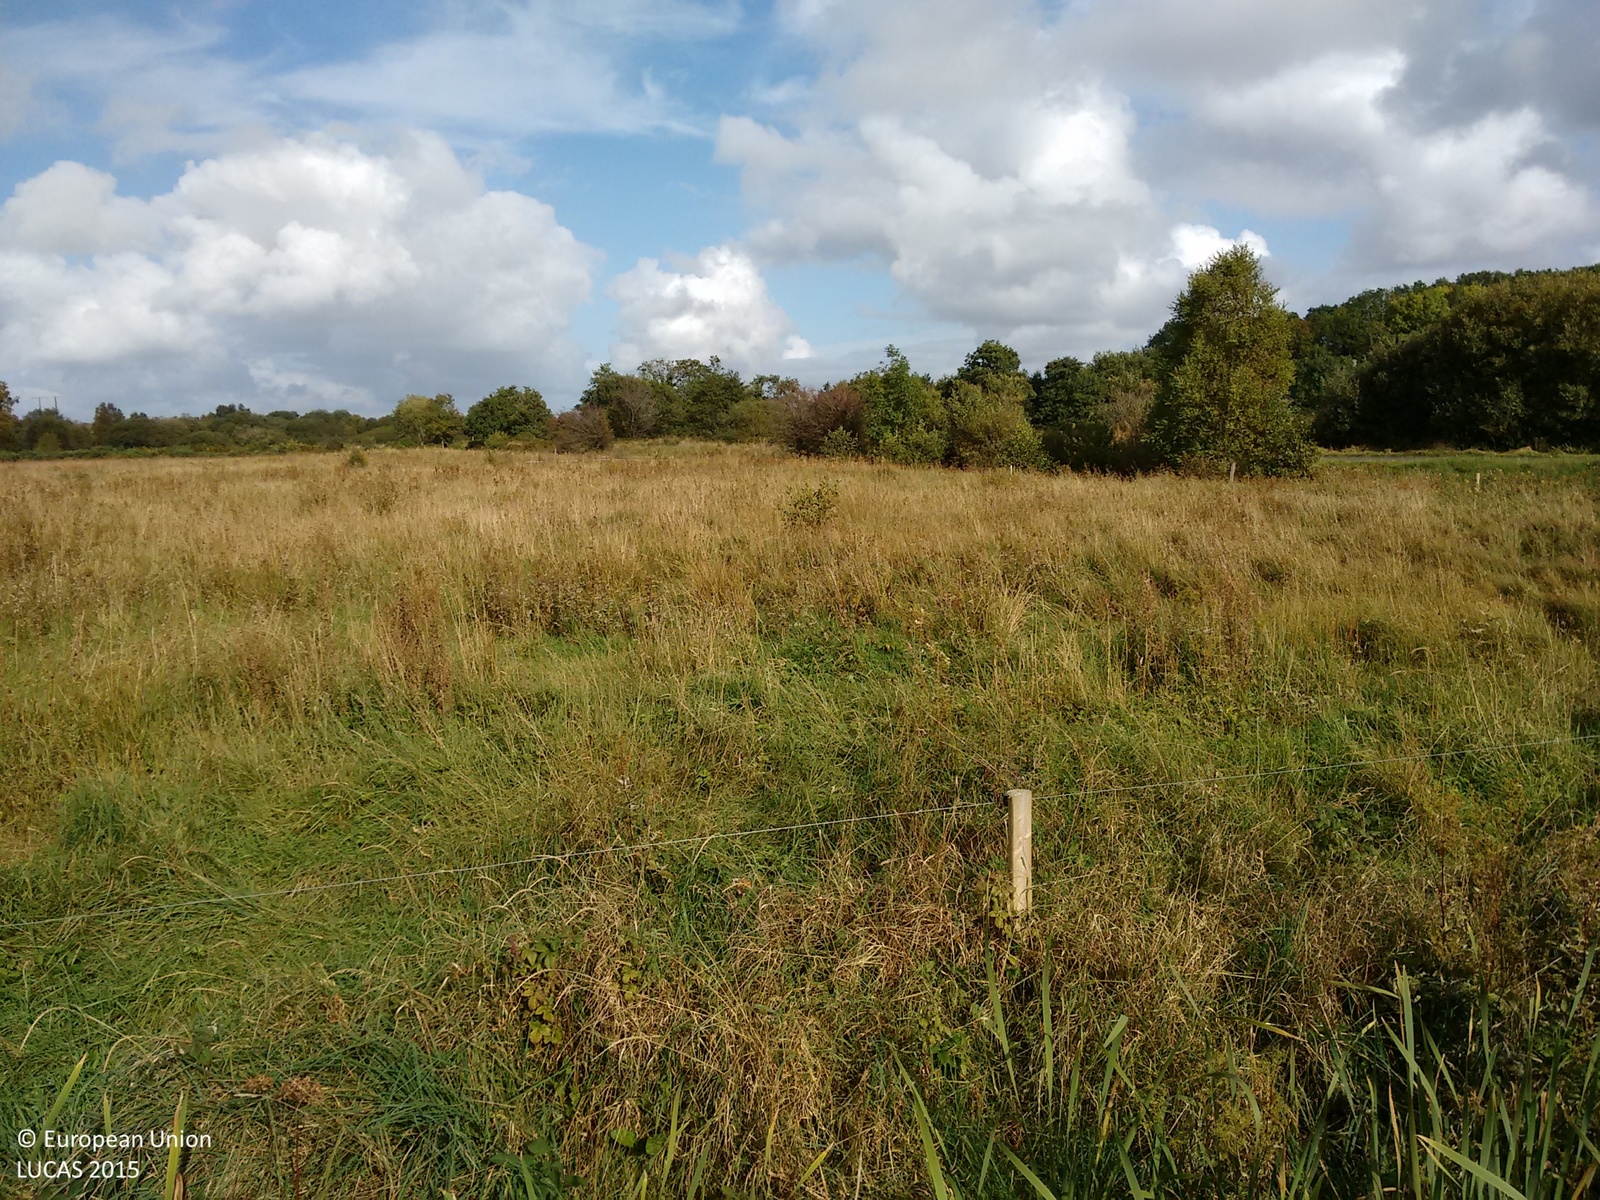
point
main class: Grassland
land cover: Grassland without tree/shrub cover
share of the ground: > 75 %
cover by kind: herbaceous plants 100 %
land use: Agriculture (excluding fallow land and kitchen gardens)
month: October
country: IE
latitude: 53.8358
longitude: -8.0623
